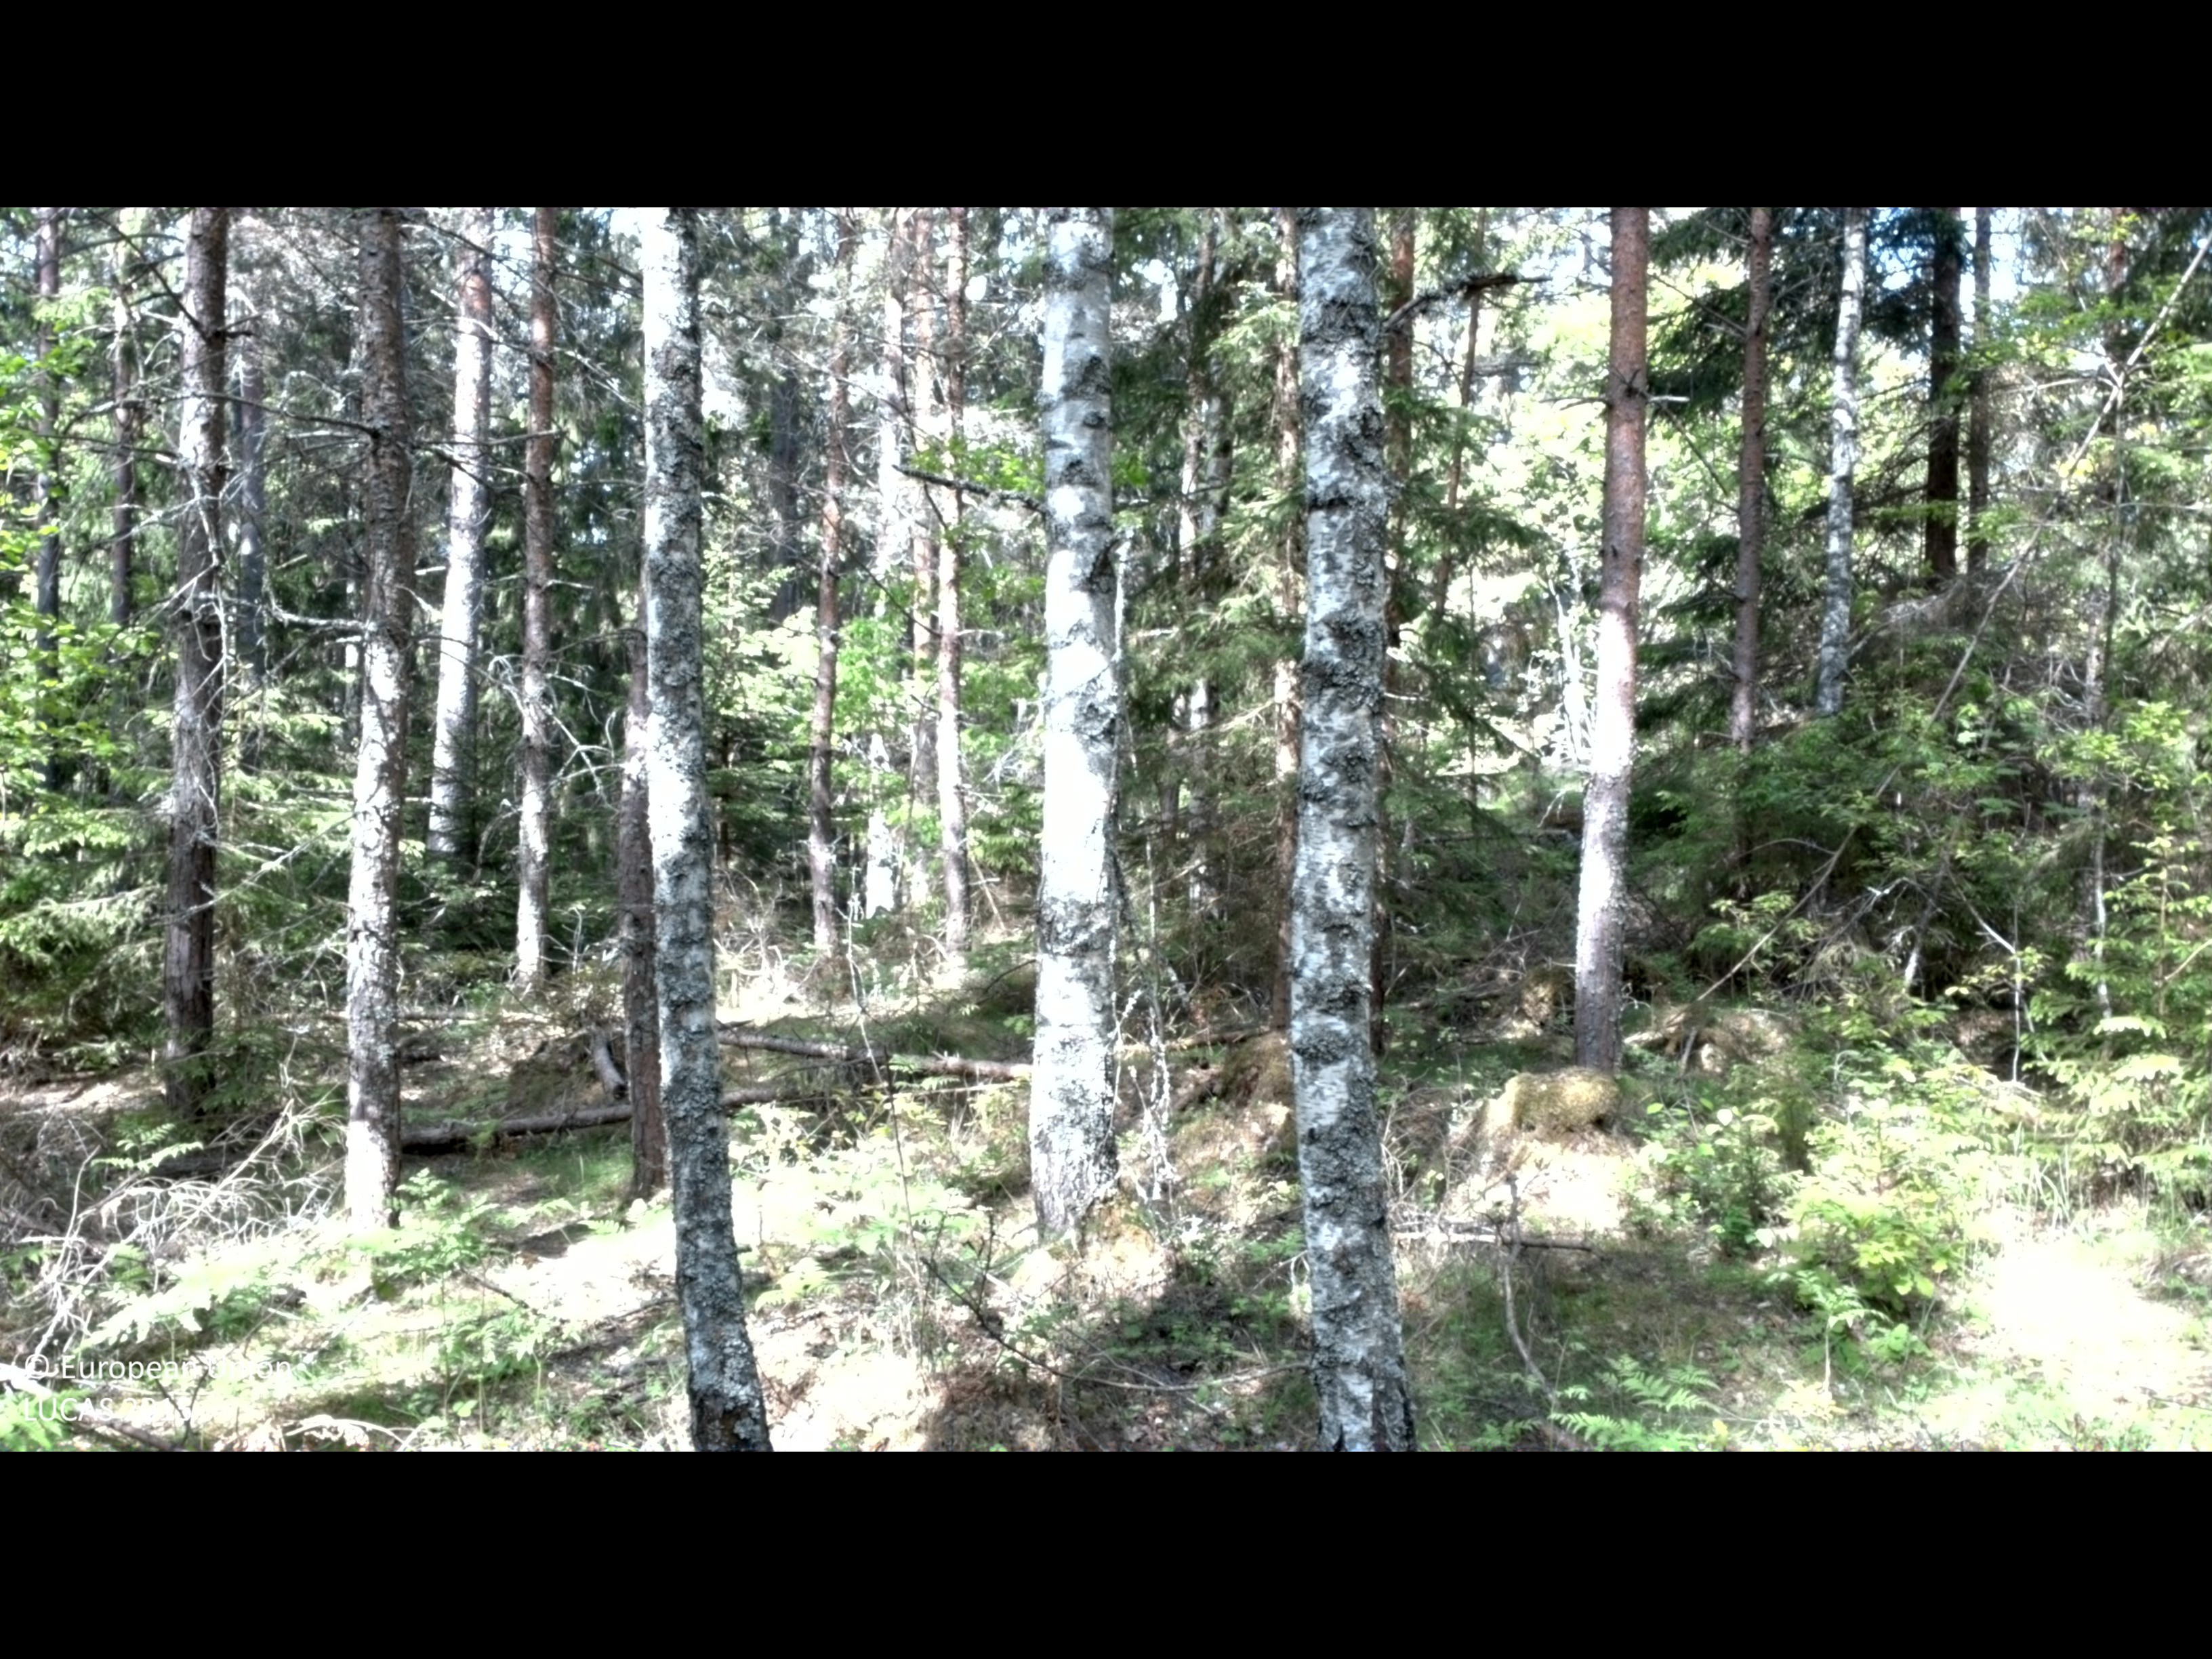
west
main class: Woodland
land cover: Other mixed woodland
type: hemiboreal forest and nemoral coniferous forest and mixed broadleaved-coniferous forest
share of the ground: 50 - 75 %
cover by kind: coniferous forest trees 50 %, broadleaved forest trees 20 %, herbaceous plants 20 %, shrubs 5 %, lichens and mosses 5 %
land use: Forestry
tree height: > 5 m
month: June
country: SE
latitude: 57.8755
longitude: 16.2527
